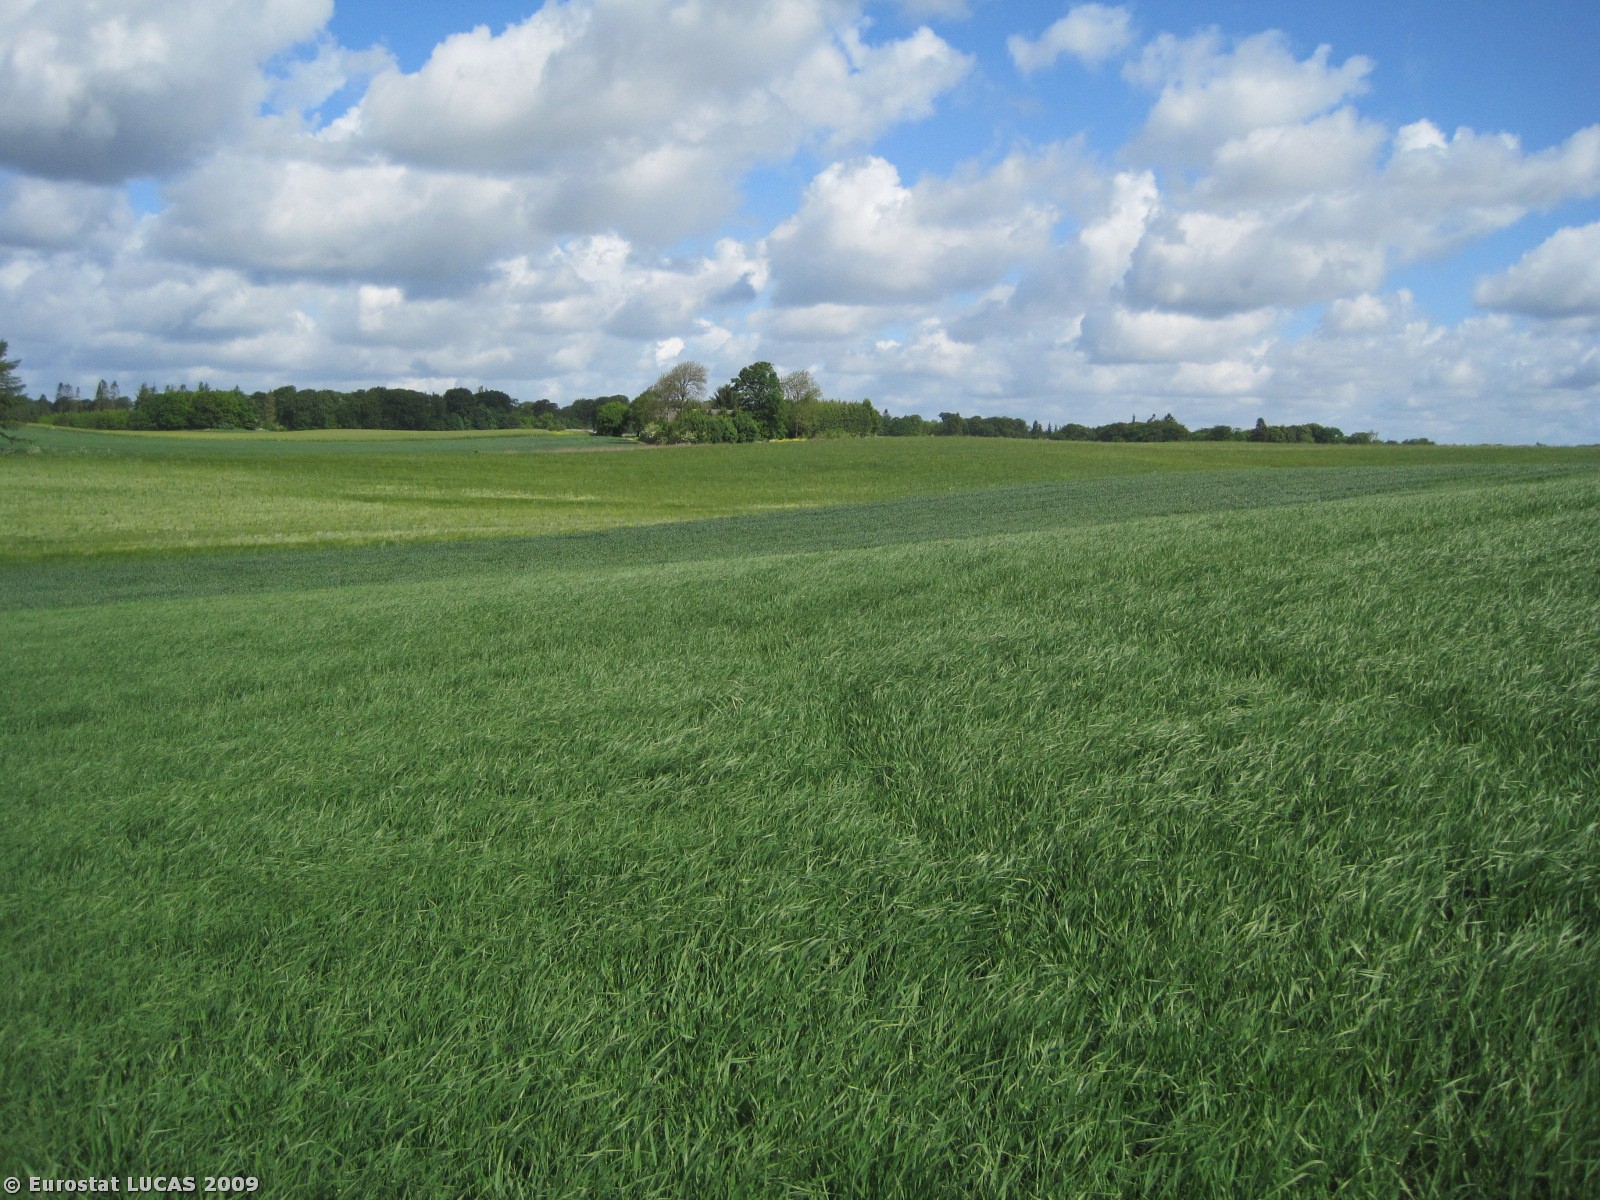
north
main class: Cropland
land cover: Barley
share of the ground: > 75 %
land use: Agriculture (excluding fallow land and kitchen gardens)
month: May
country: DK
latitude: 56.5649
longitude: 9.6912
